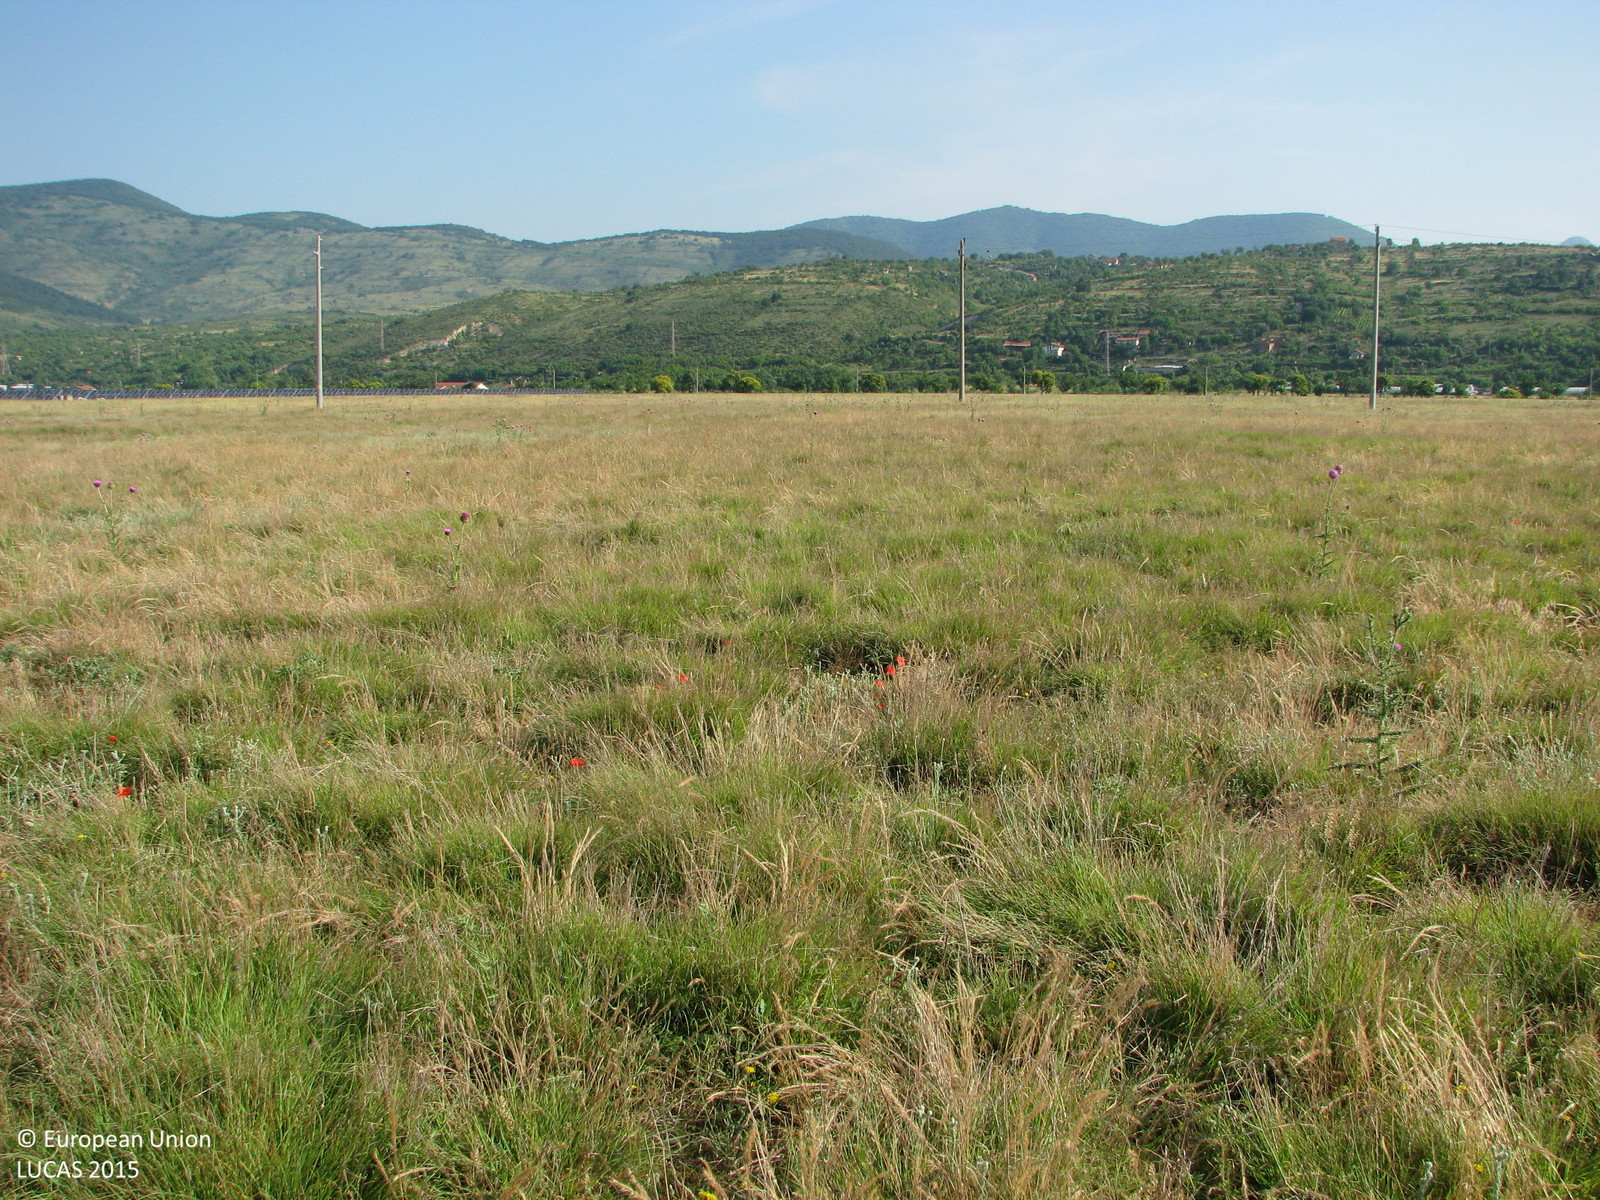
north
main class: Grassland
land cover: Grassland without tree/shrub cover
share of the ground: > 75 %
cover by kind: herbaceous plants 100 %
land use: Agriculture (excluding fallow land and kitchen gardens)
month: June
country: BG
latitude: 42.6470
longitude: 26.2995
